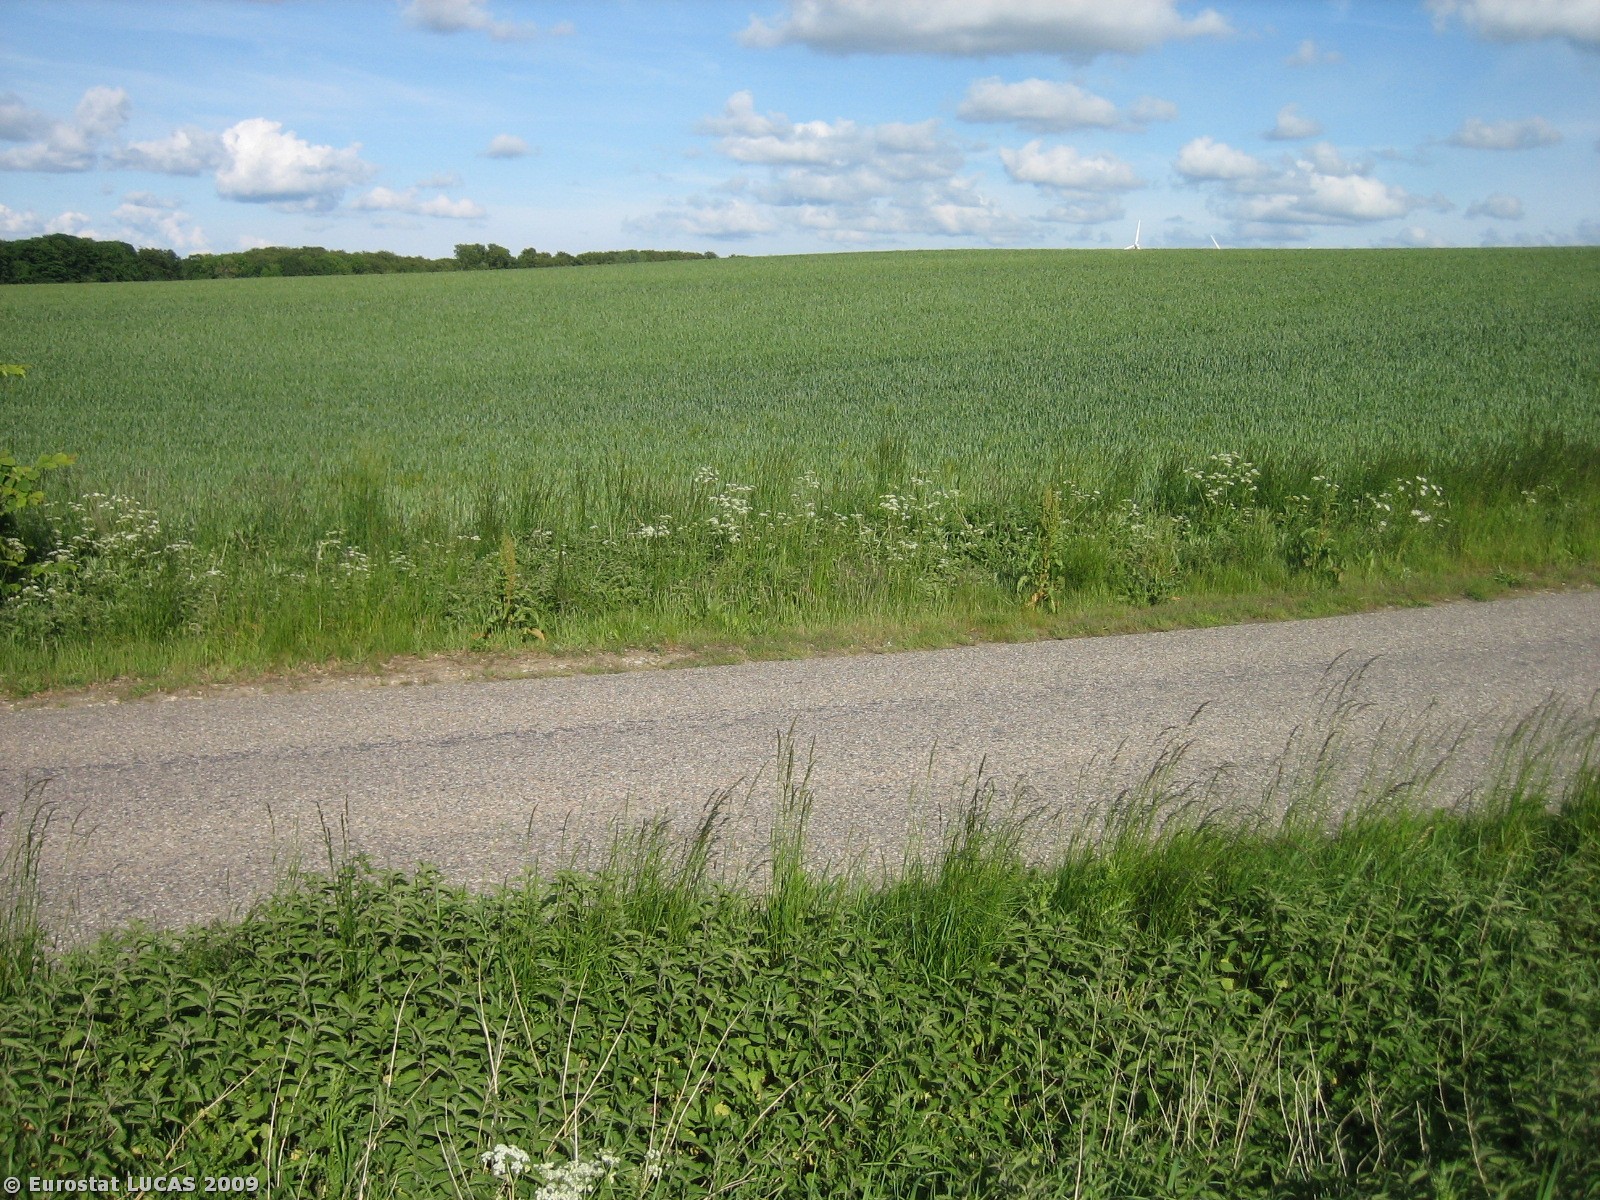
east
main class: Cropland
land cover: Common wheat
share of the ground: > 75 %
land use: Agriculture (excluding fallow land and kitchen gardens)
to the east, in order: Common wheat; Grass margins; Ditches and canals; Grass margins; Paved roads, cycling and walking lanes; Grass margins; Ditches and canals; Grass margins; Common wheat
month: June
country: DK
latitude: 56.1515
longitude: 9.7267
